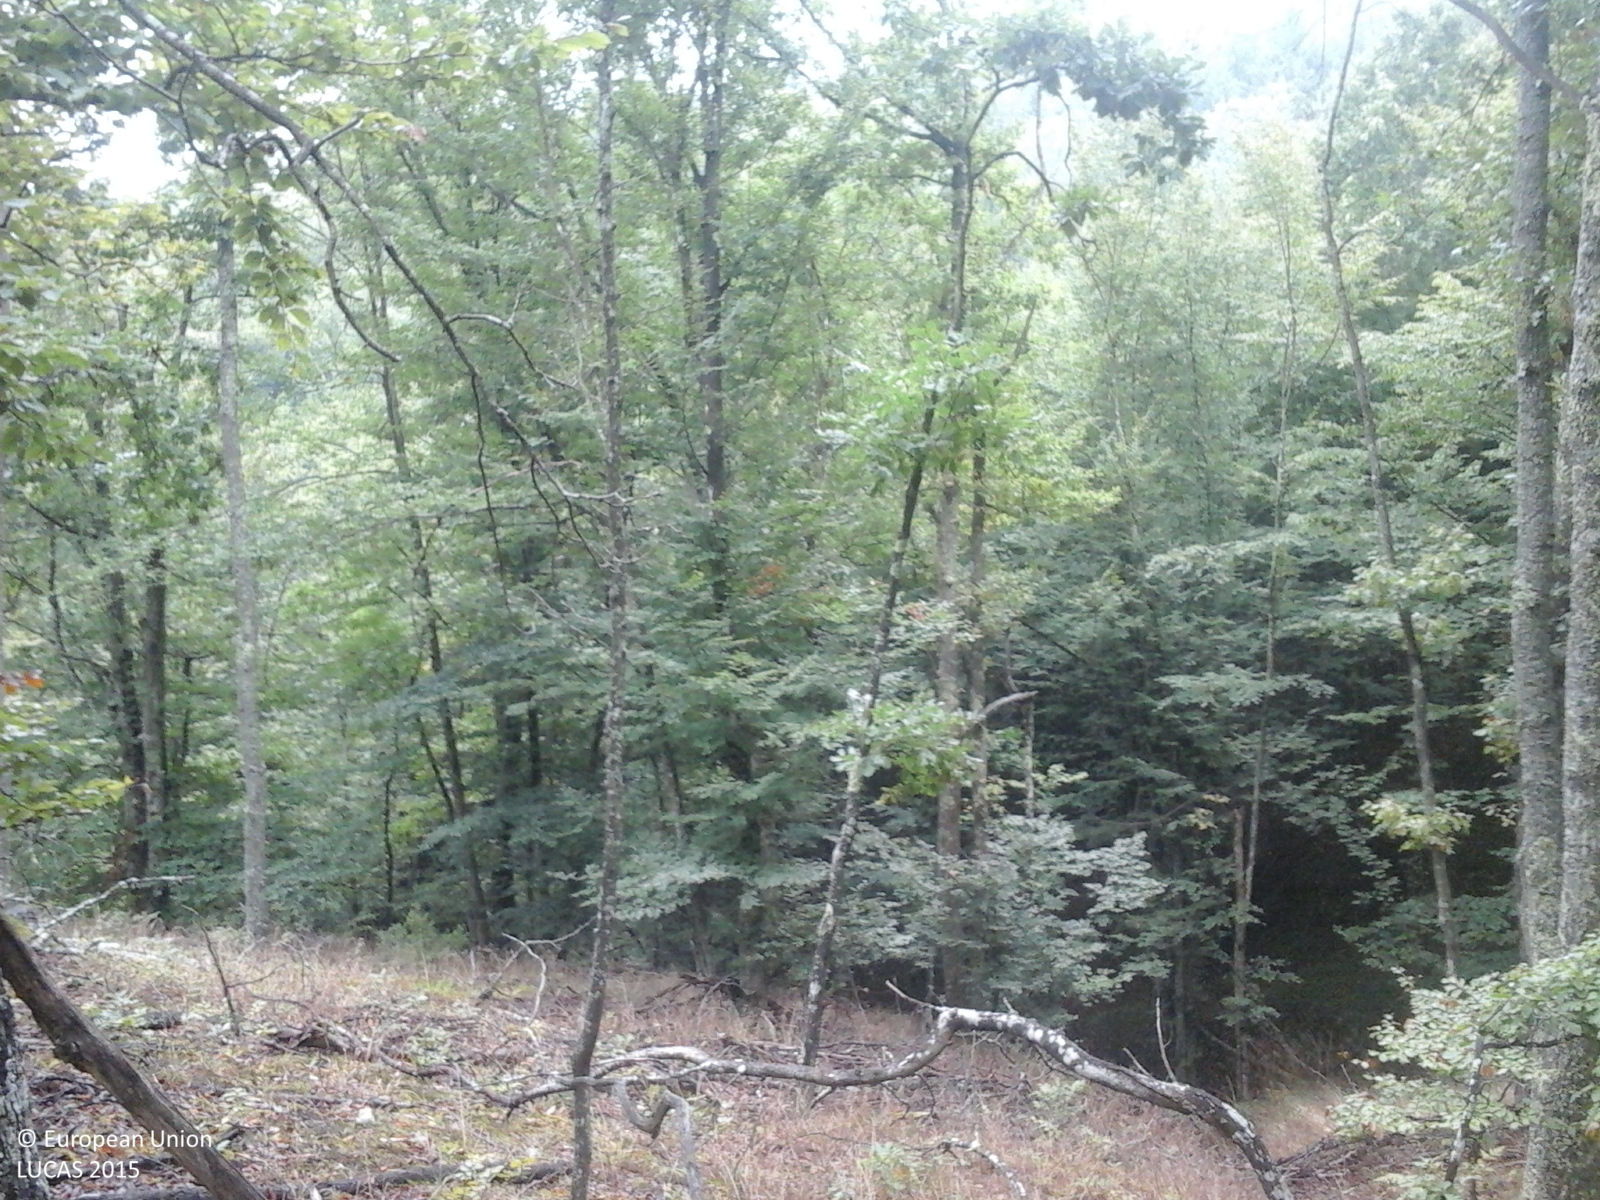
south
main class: Woodland
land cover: Broadleaved woodland
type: acidophilous oak and oak-birch forest
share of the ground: > 75 %
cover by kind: broadleaved forest trees 100 %
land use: Forestry
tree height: > 5 m
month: September
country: RO
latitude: 45.7393
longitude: 22.2139
